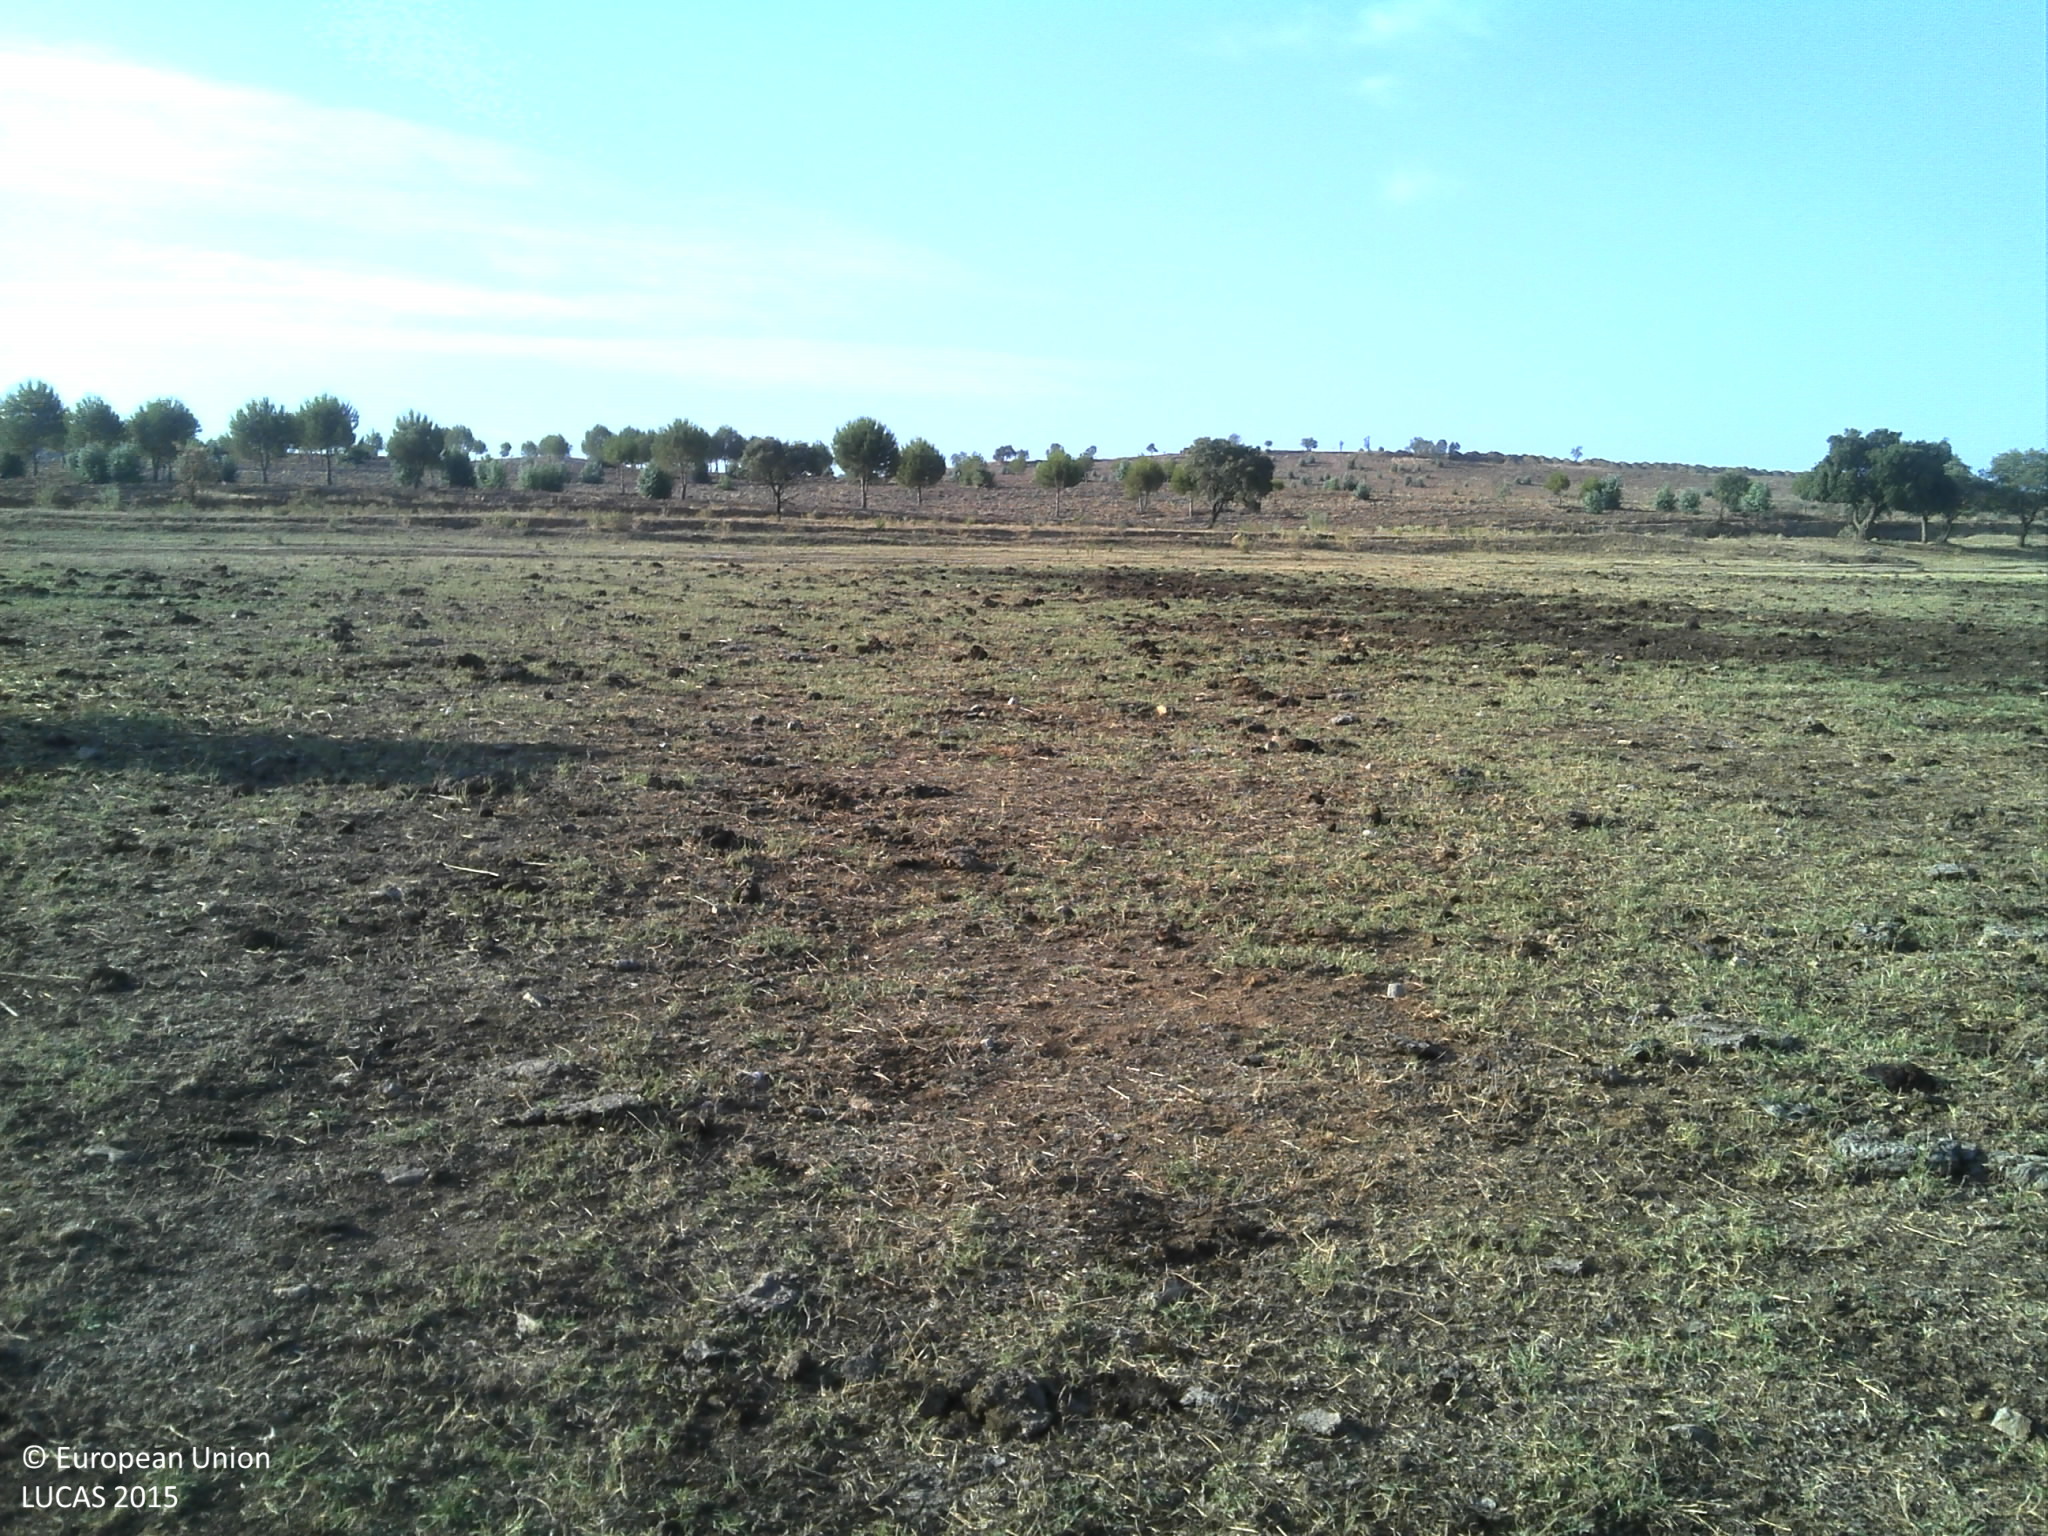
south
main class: Grassland
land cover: Grassland without tree/shrub cover
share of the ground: 10 - 25 %
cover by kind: unconsolidated bare surface 70 %, herbaceous plants 25 %
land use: Agriculture (excluding fallow land and kitchen gardens)
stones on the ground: 10 - 25 %
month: June
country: PT
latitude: 39.8969
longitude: -7.2042
